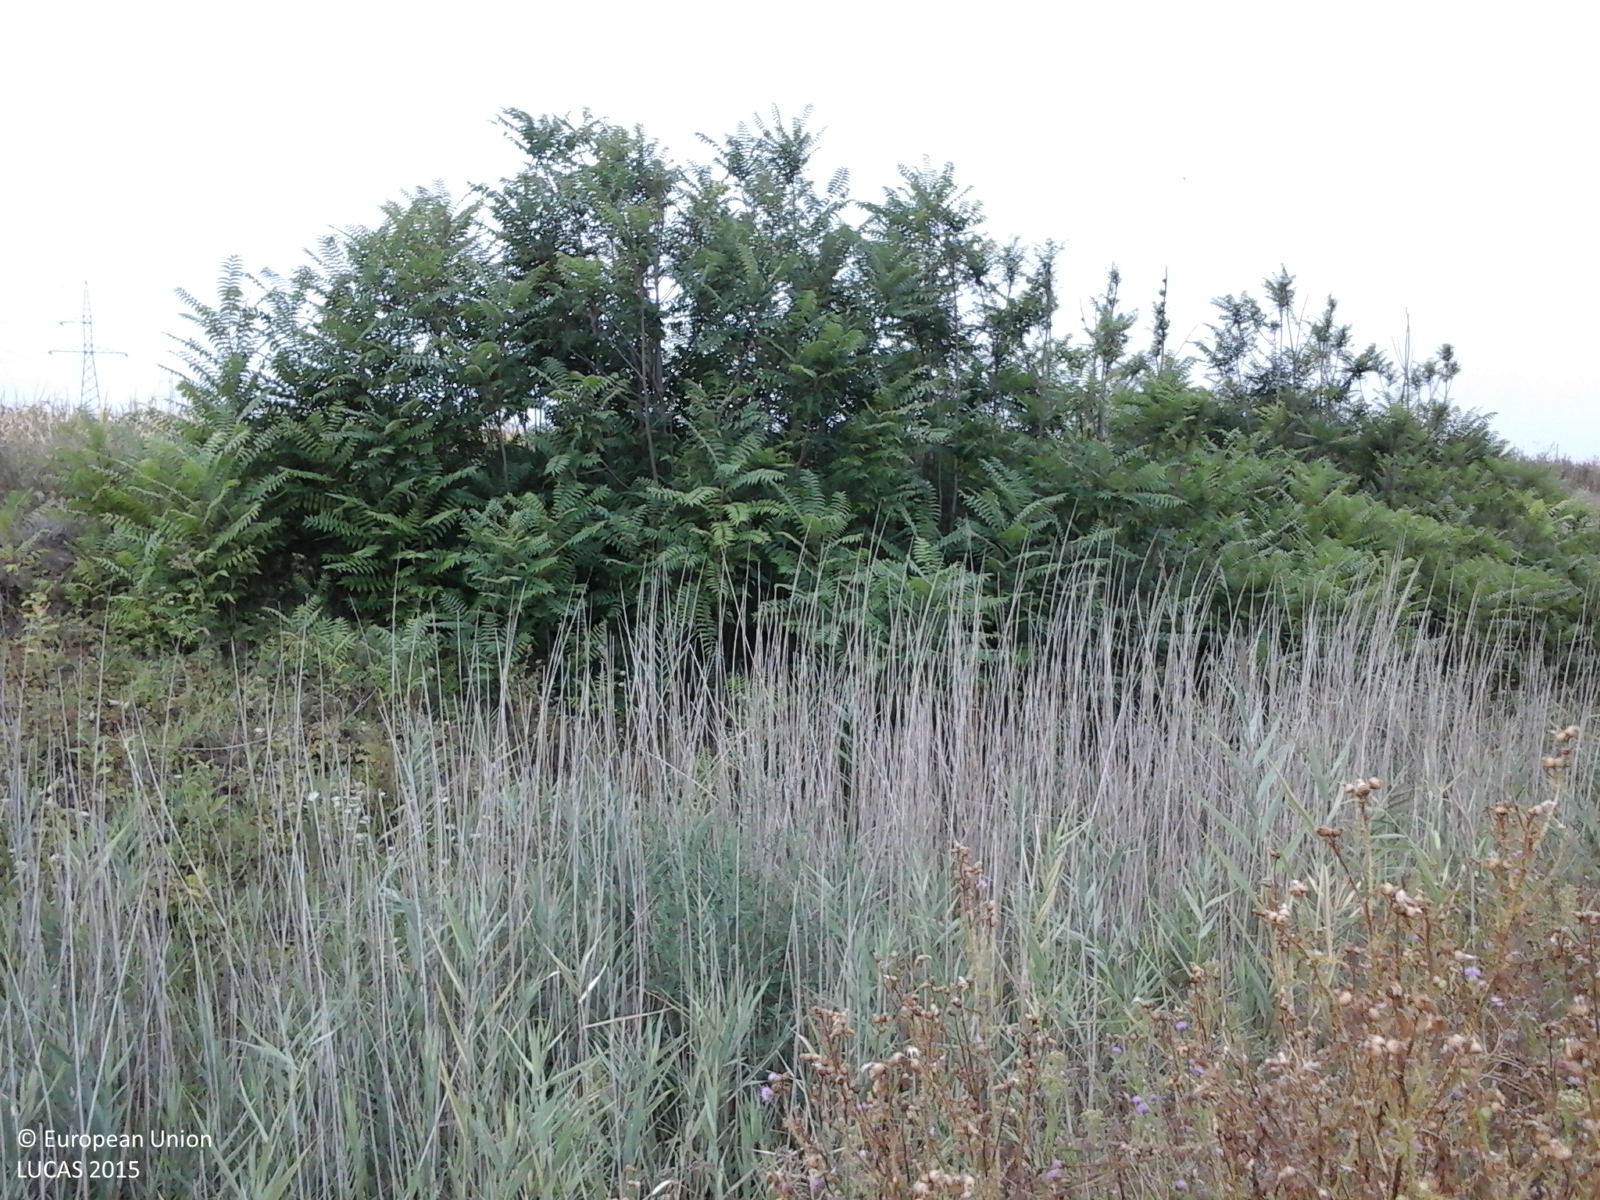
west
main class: Cropland
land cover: Maize
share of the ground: > 75 %
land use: Agriculture (excluding fallow land and kitchen gardens)
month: August
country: RO
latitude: 45.8135
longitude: 20.6937
